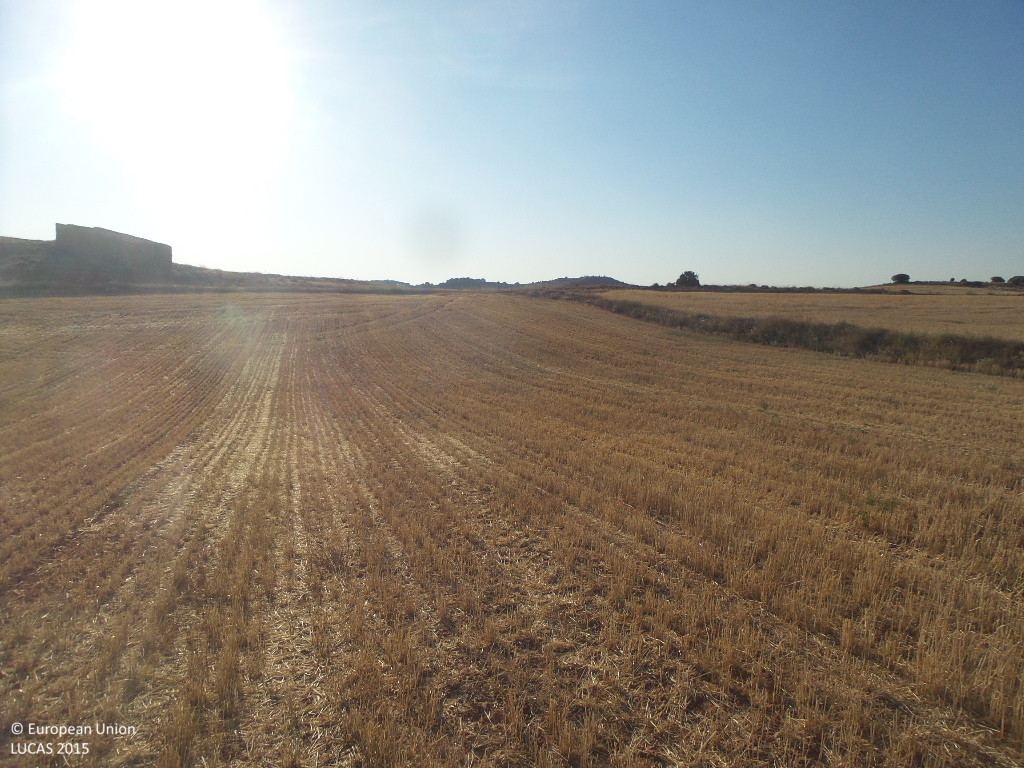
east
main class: Cropland
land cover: Barley
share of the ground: < 10 %
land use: Agriculture (excluding fallow land and kitchen gardens)
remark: Harvested field
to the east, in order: Barley; Grass margins; Tracks; Spontaneously vegetated surfaces; Shrubland without tree cover; Spontaneously vegetated surfaces; Common wheat; Grass margins; Tracks; Barley; Grass margins; Barley
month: July
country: ES
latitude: 41.2721
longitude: -2.0737
